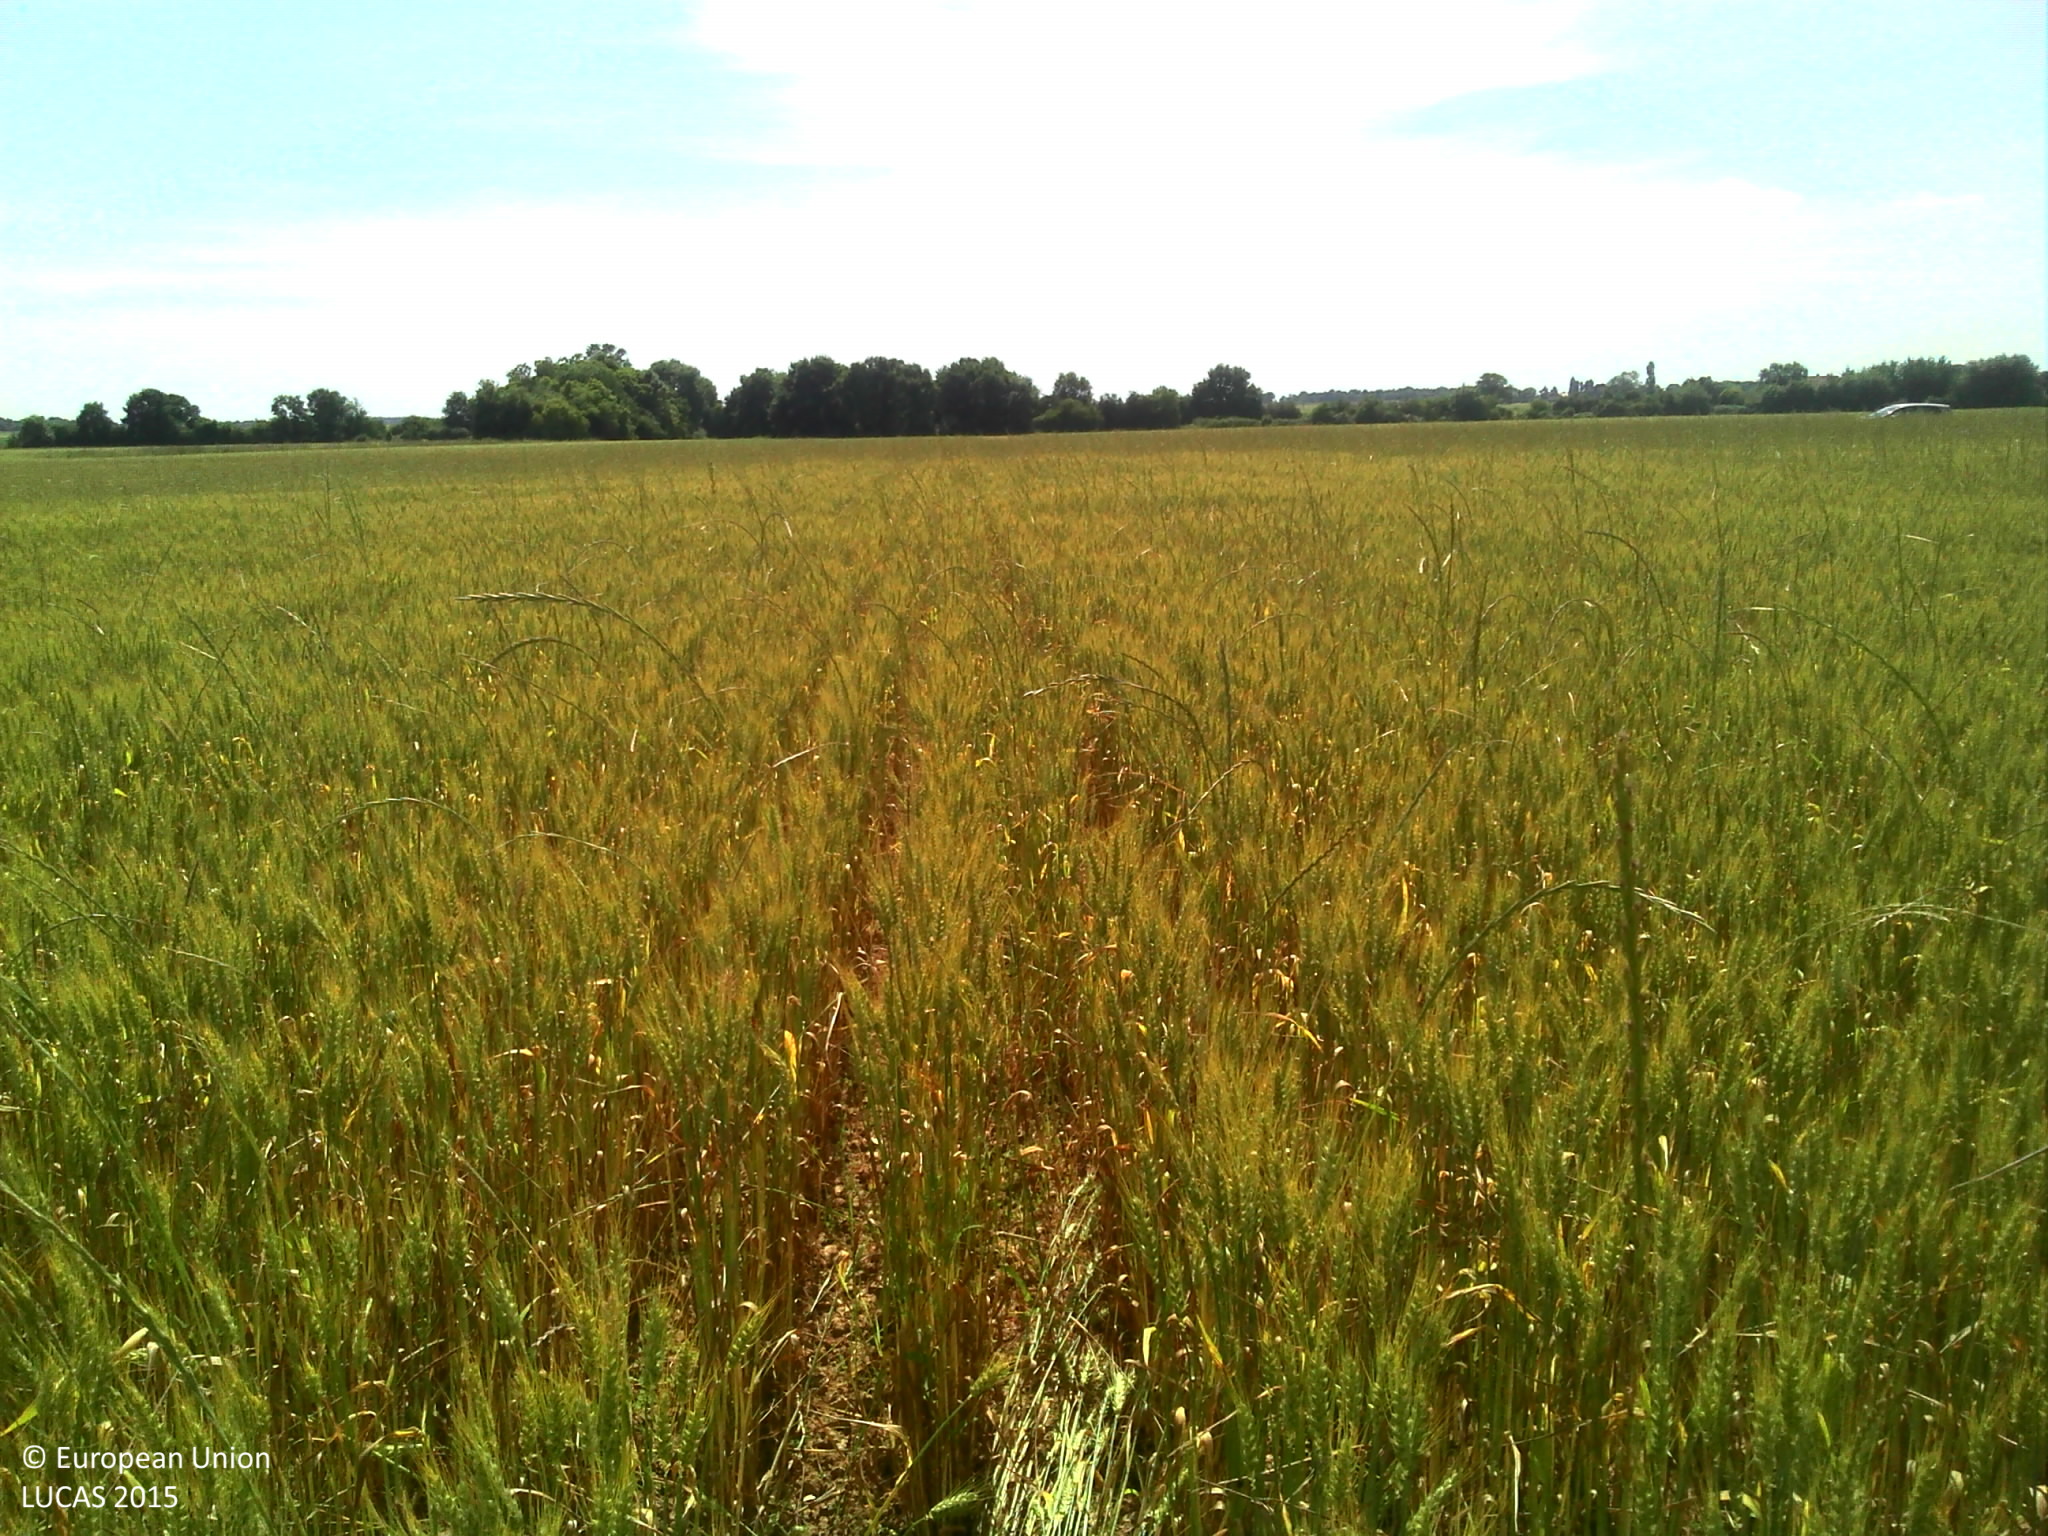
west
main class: Cropland
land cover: Common wheat
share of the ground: > 75 %
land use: Agriculture (excluding fallow land and kitchen gardens)
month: June
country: FR
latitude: 49.0730
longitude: 1.0673
